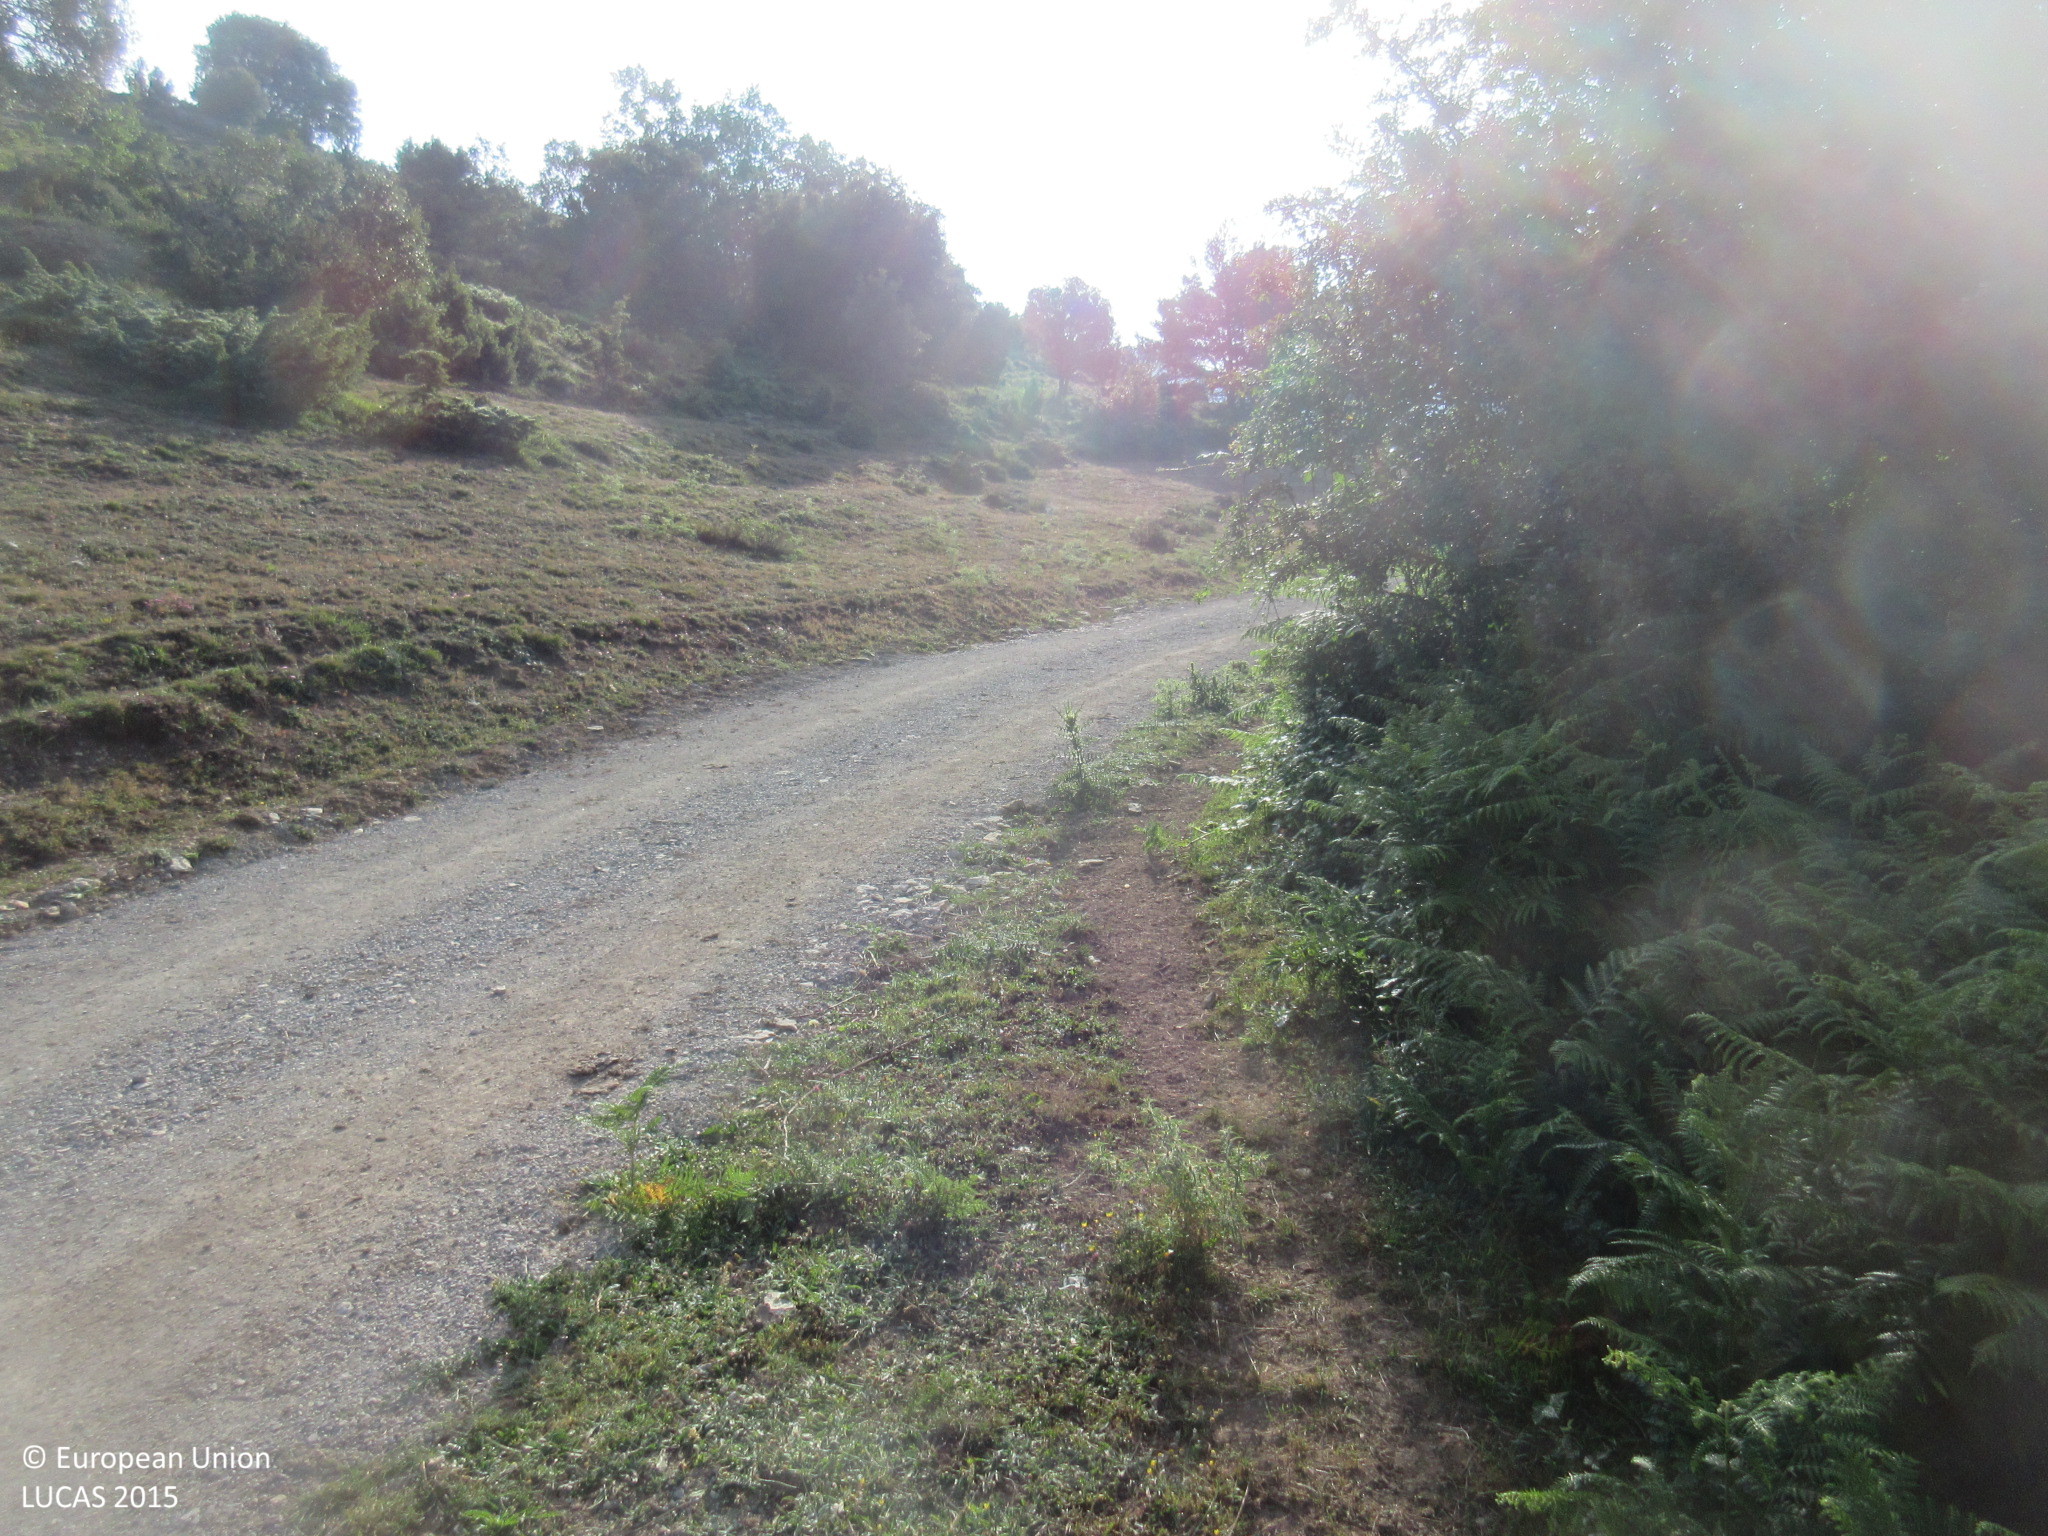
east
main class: Woodland
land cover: Broadleaved woodland
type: thermophilous deciduous forest
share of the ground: > 75 %
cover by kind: broadleaved forest trees 80 %, herbaceous plants 20 %
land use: Agriculture (excluding fallow land and kitchen gardens)
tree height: > 5 m
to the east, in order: Broadleaved woodland; Tracks; Grassland without tree/shrub cover; Other bare soil; Grassland with sparse tree/shrub cover; Tracks; Shrubland with sparse tree cover; Grassland with sparse tree/shrub cover
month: July
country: ES
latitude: 43.0587
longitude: -3.3854
